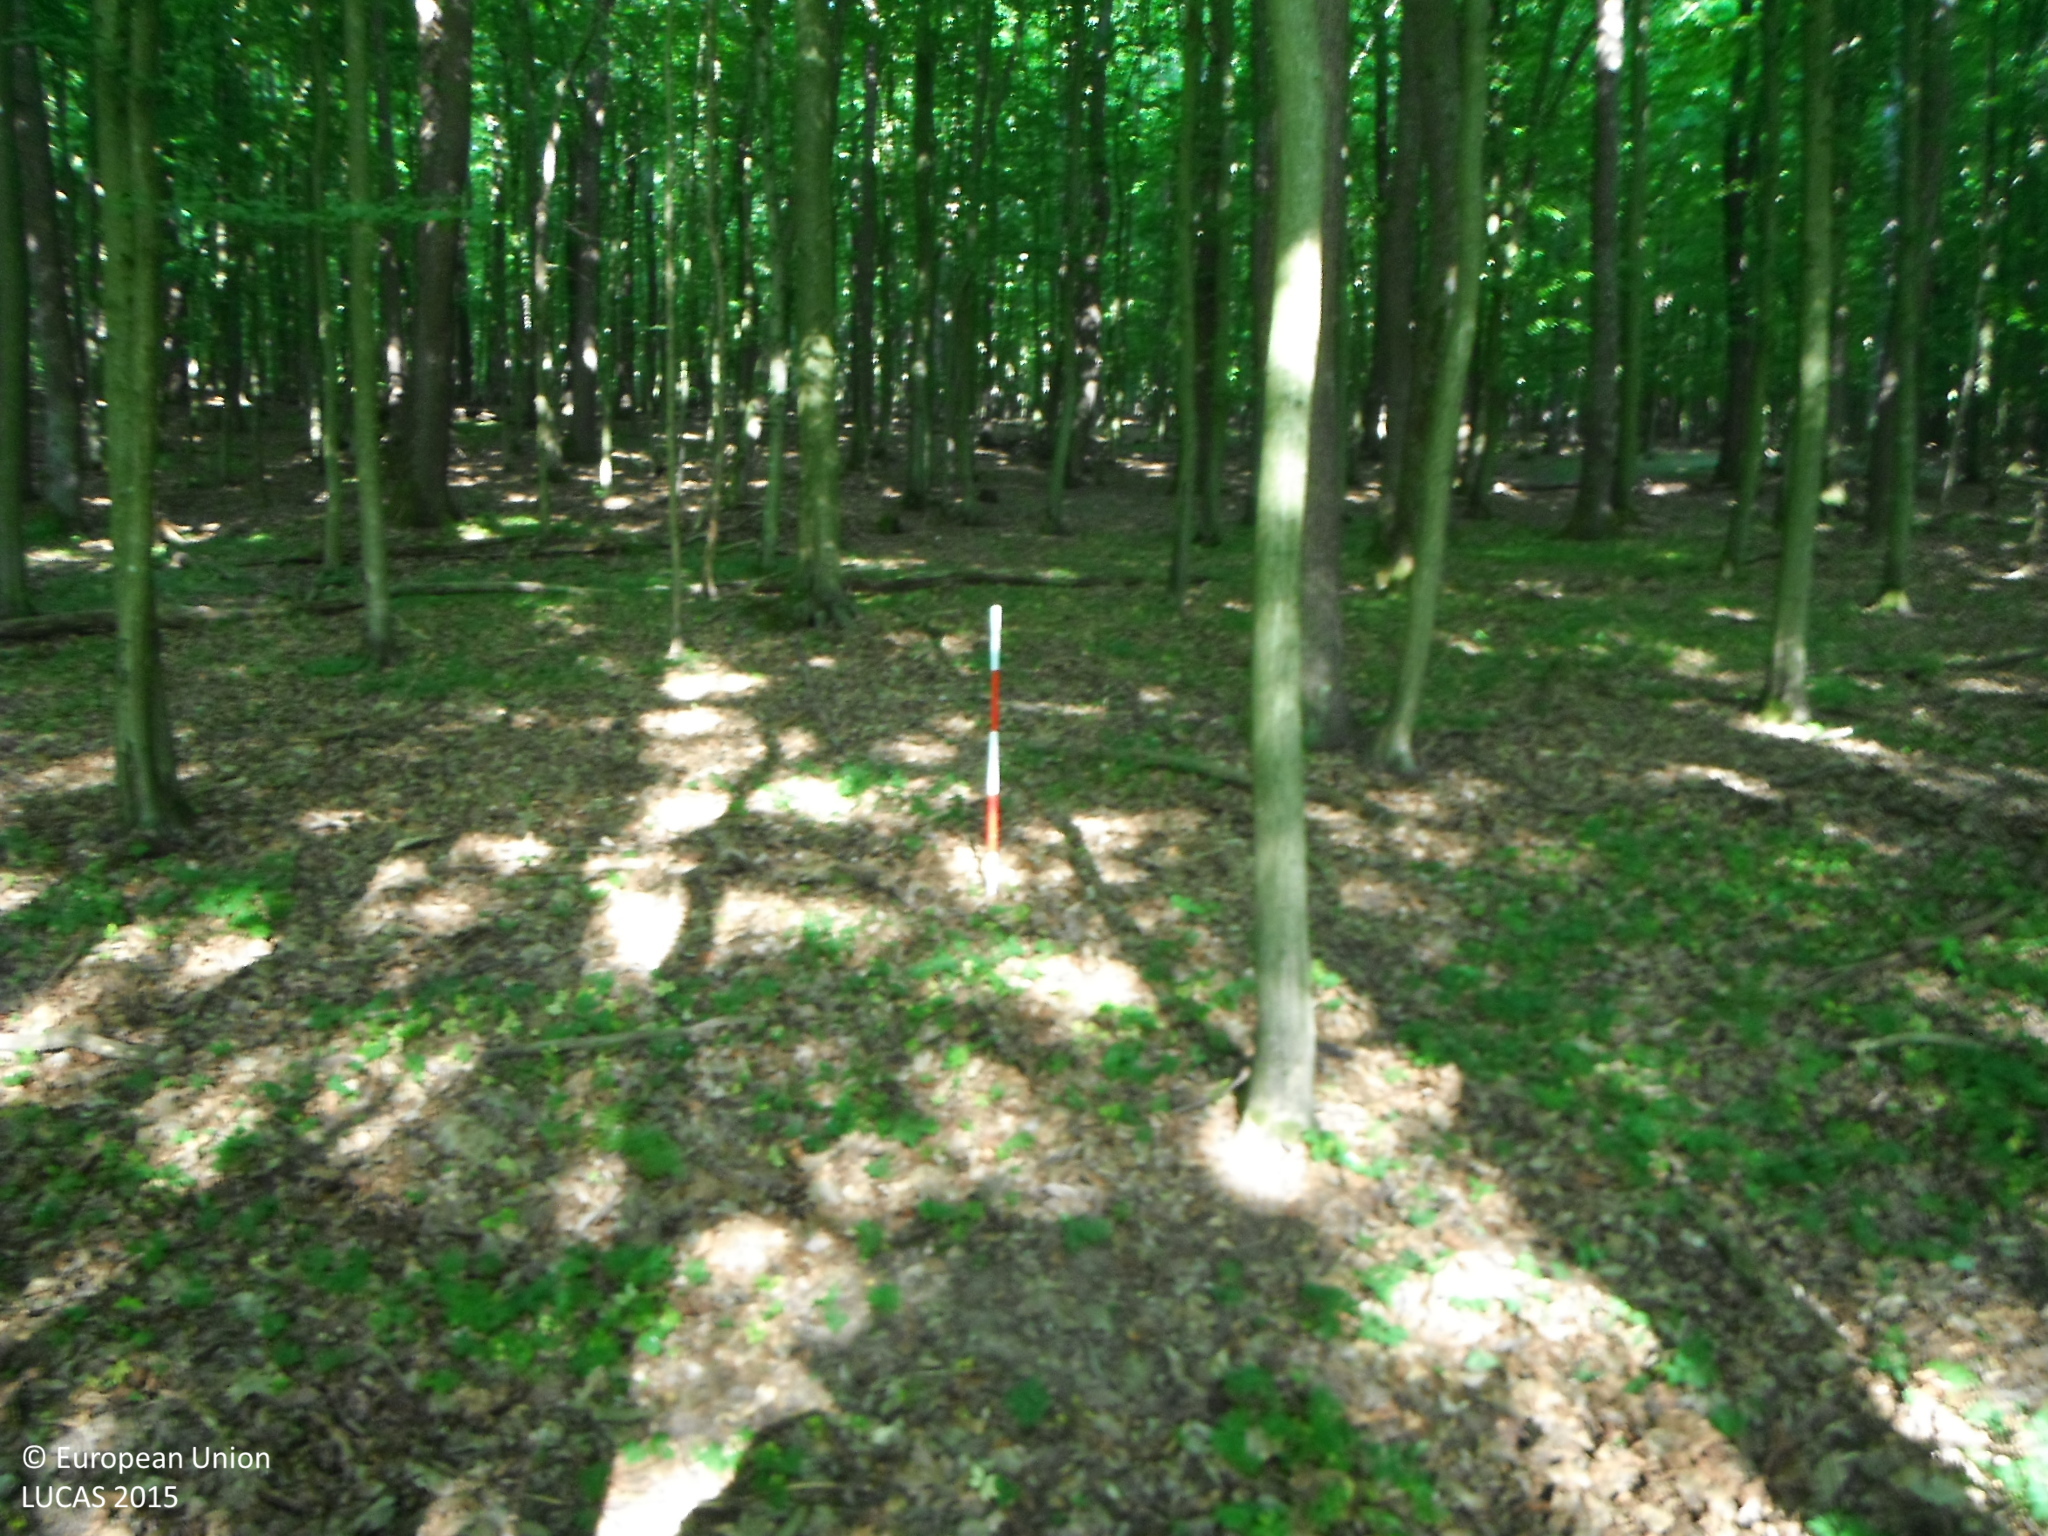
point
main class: Woodland
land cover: Broadleaved woodland
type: beech forest
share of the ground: > 75 %
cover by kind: broadleaved forest trees 100 %
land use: Forestry
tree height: > 5 m
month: May
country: SK
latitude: 48.6851
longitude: 21.0304
